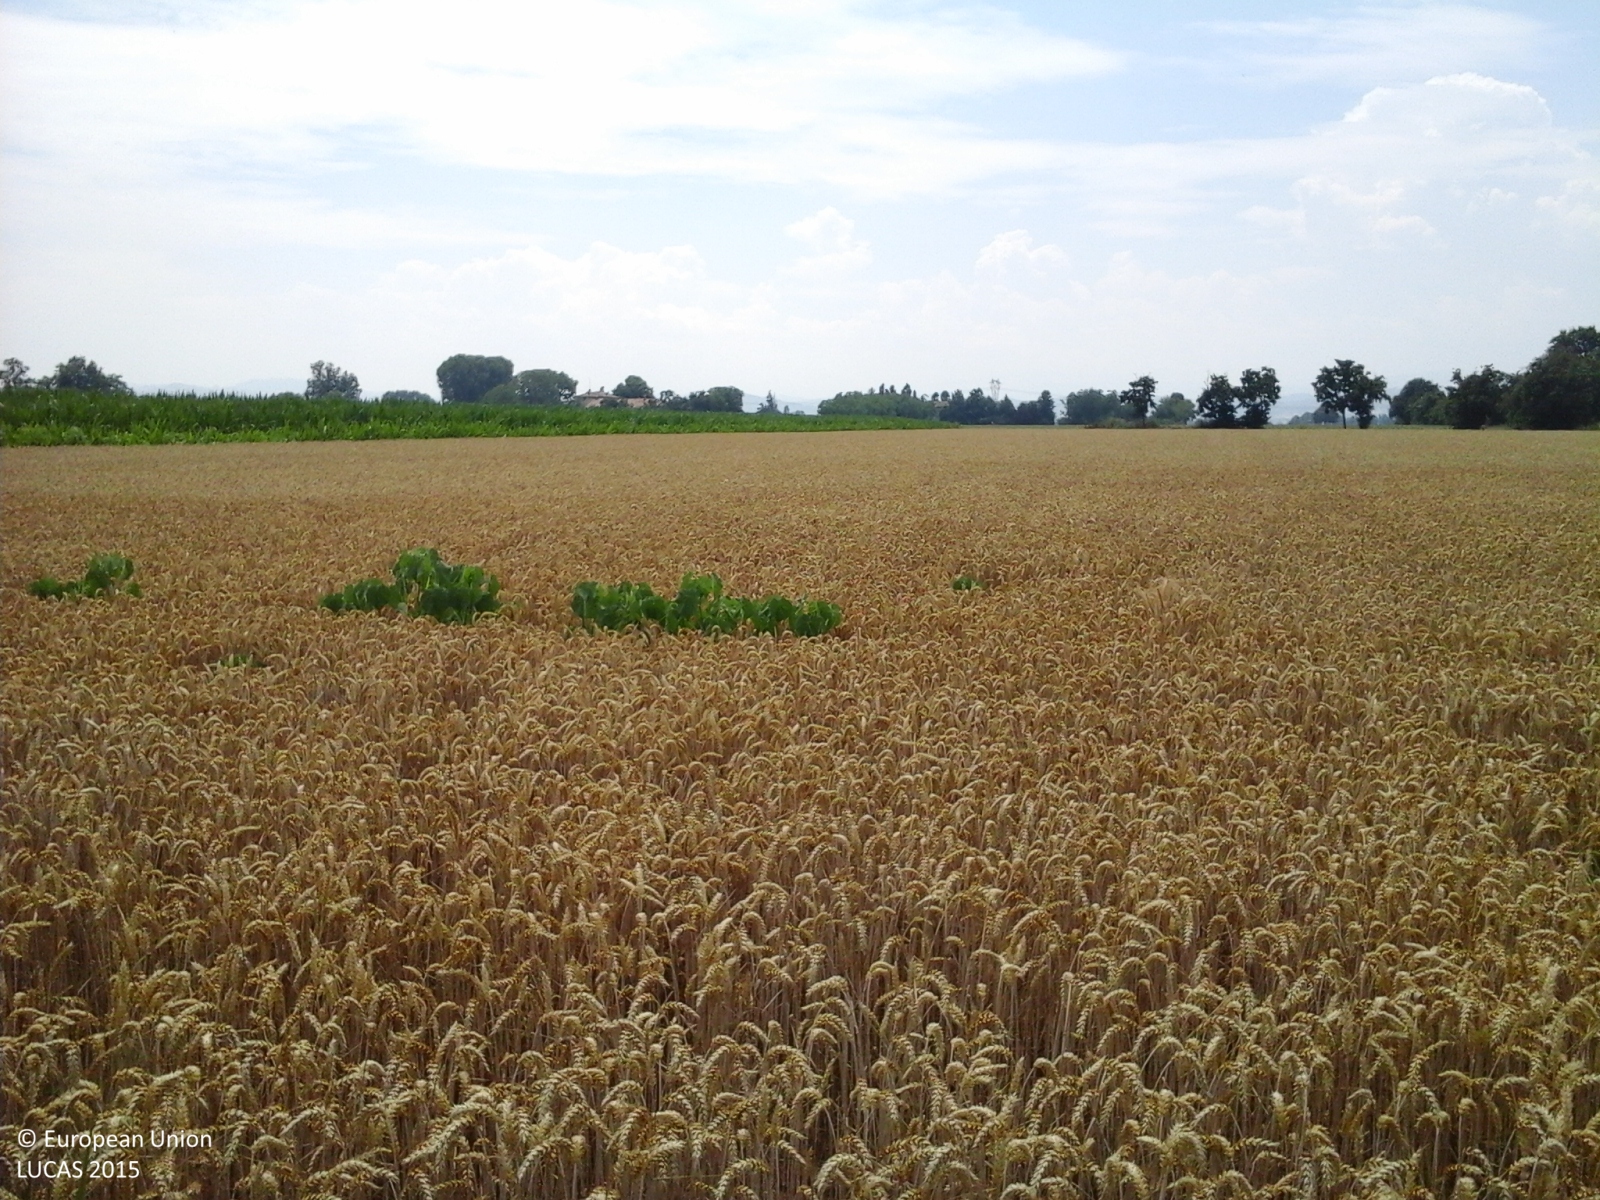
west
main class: Cropland
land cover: Common wheat
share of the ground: > 75 %
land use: Agriculture (excluding fallow land and kitchen gardens)
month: June
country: IT
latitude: 44.7105
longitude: 10.3905
